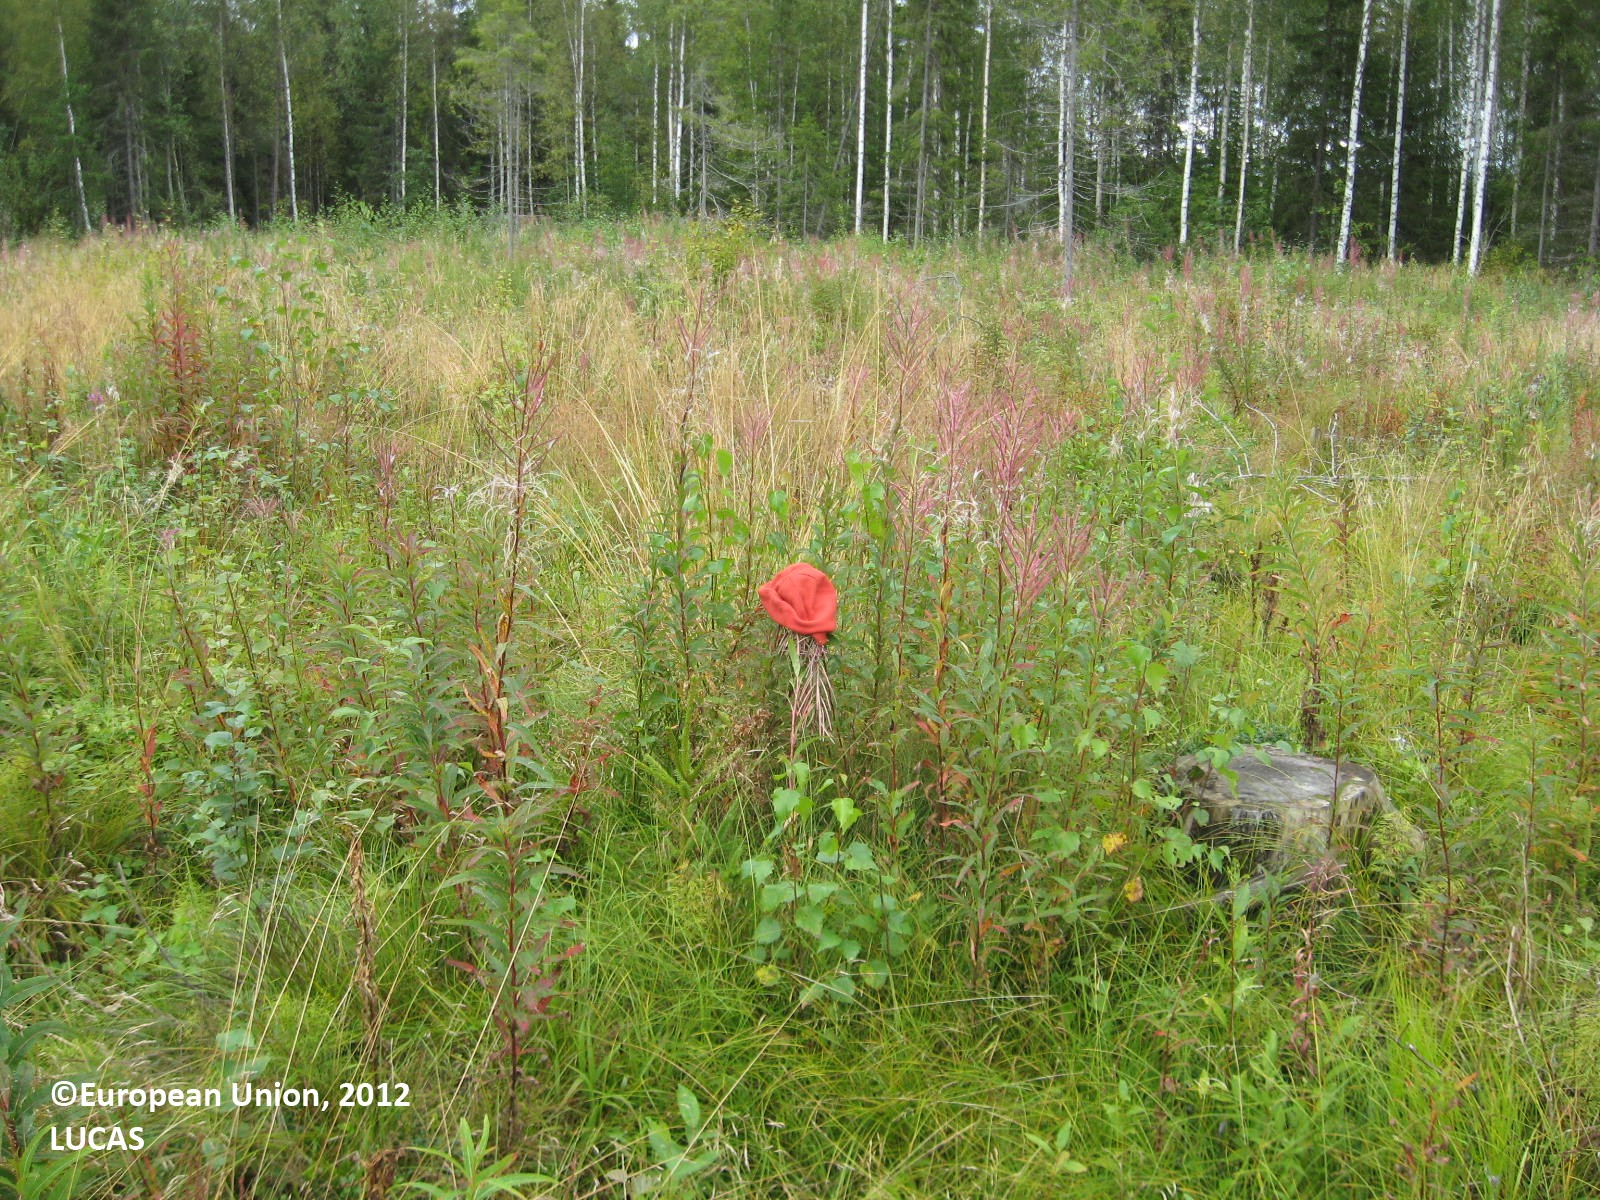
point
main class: Shrubland
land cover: Shrubland without tree cover
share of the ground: 50 - 75 %
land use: Forestry
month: August
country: FI
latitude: 63.6603
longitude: 29.0132
